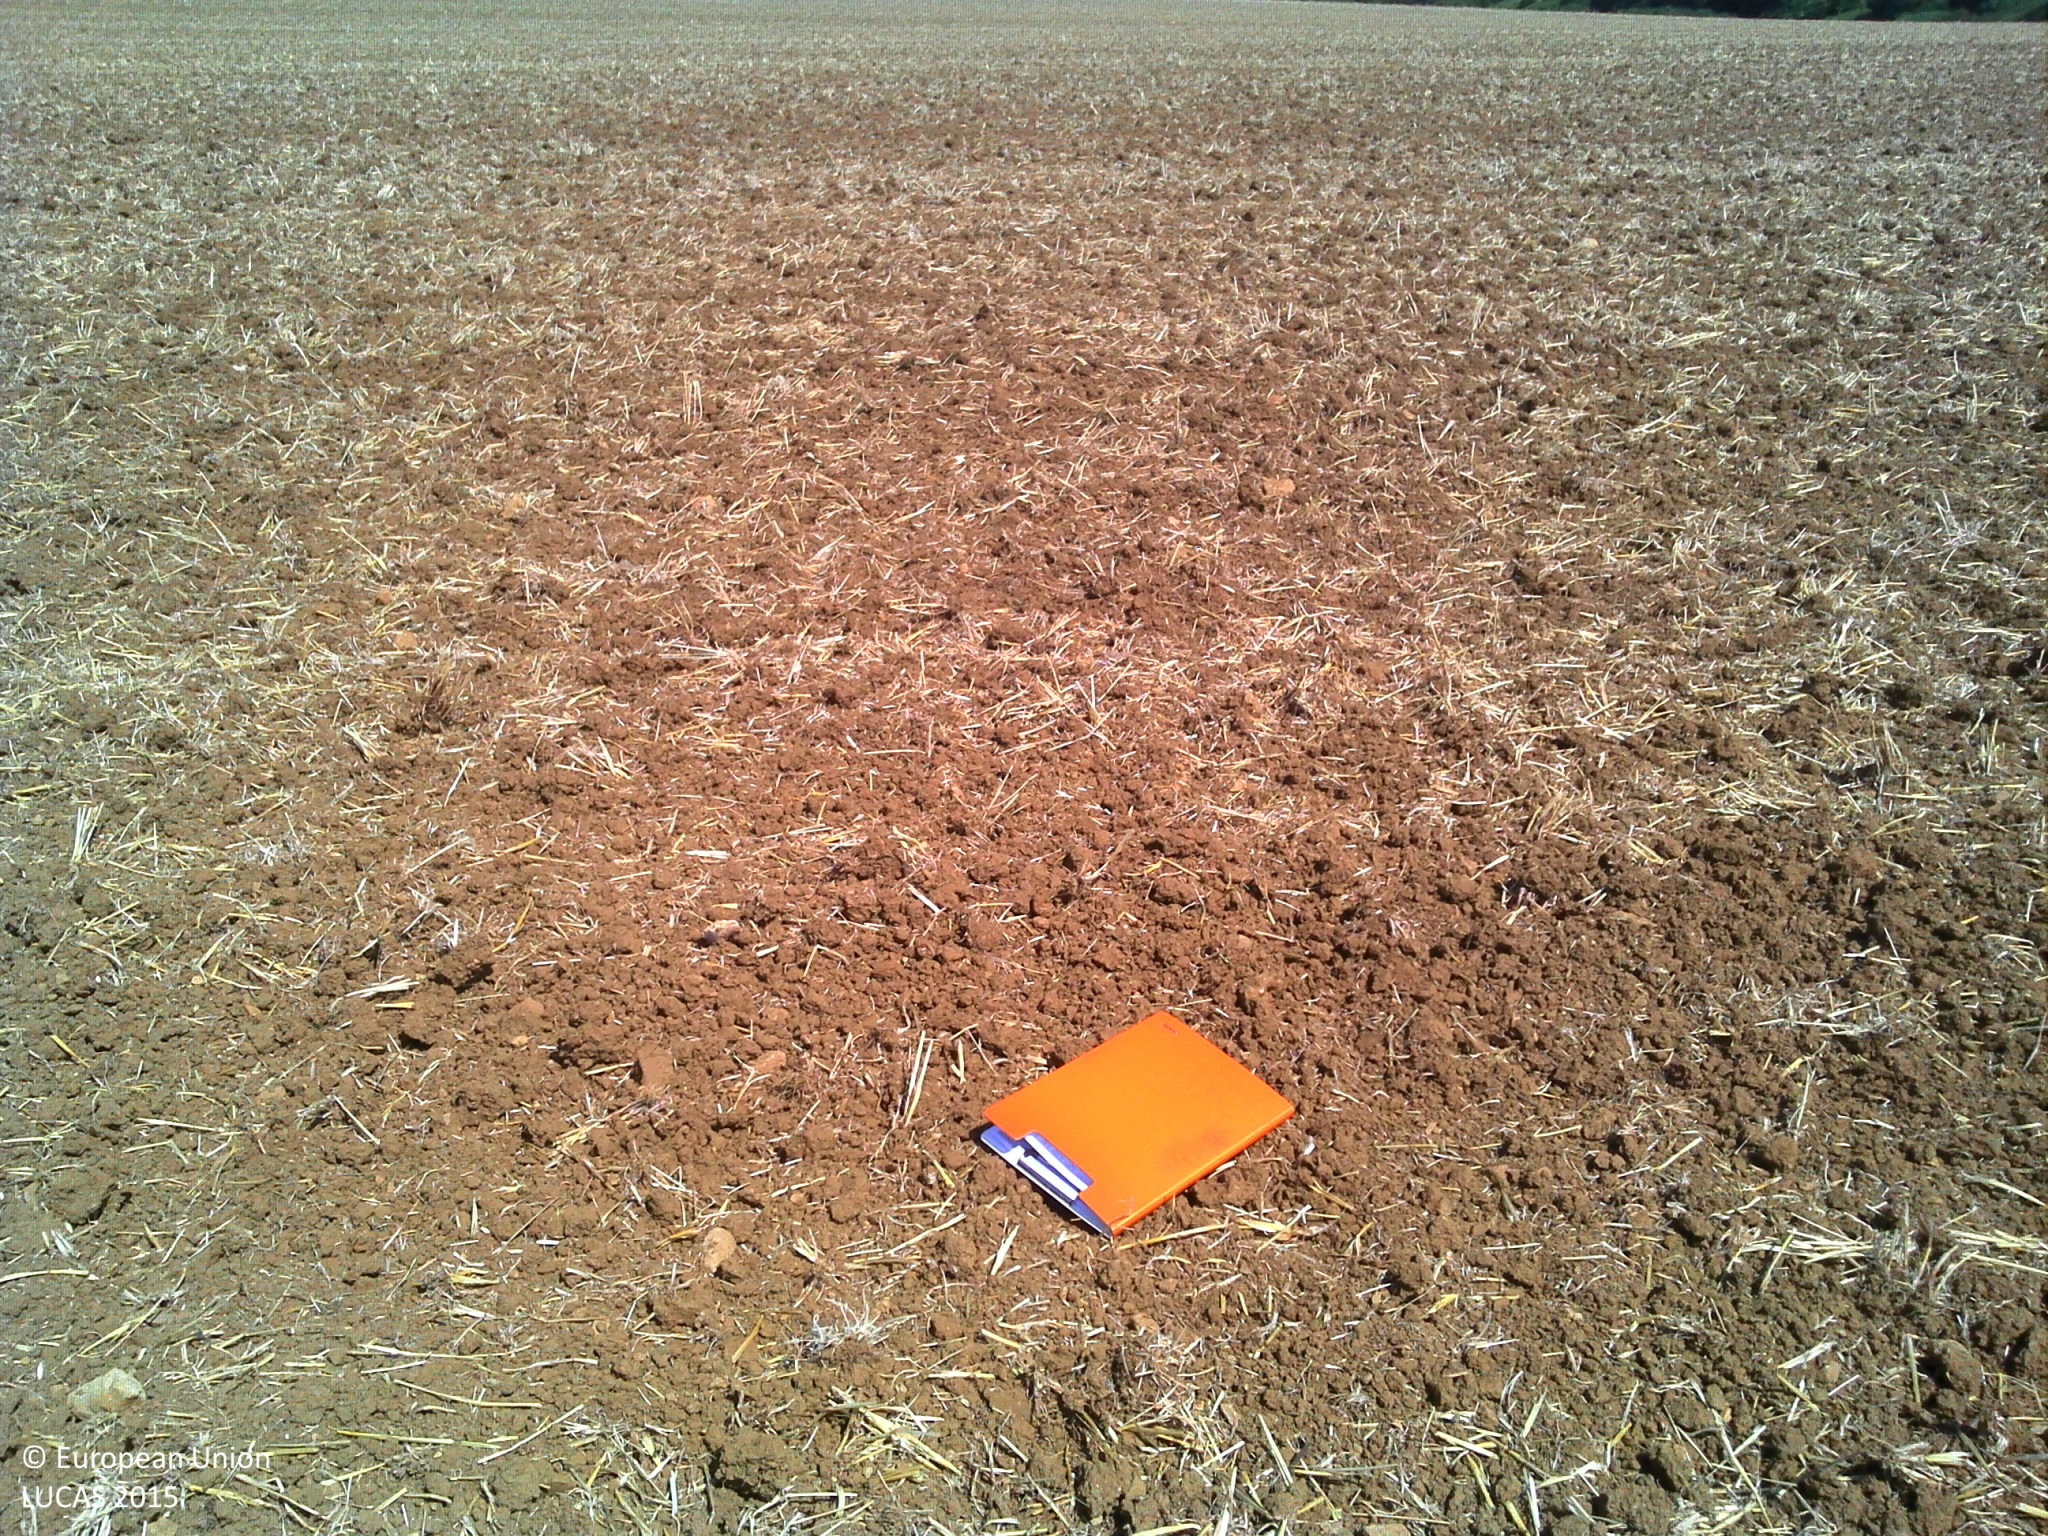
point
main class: Cropland
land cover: Barley
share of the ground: < 10 %
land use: Agriculture (excluding fallow land and kitchen gardens)
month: July
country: FR
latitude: 48.0917
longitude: 4.9910
